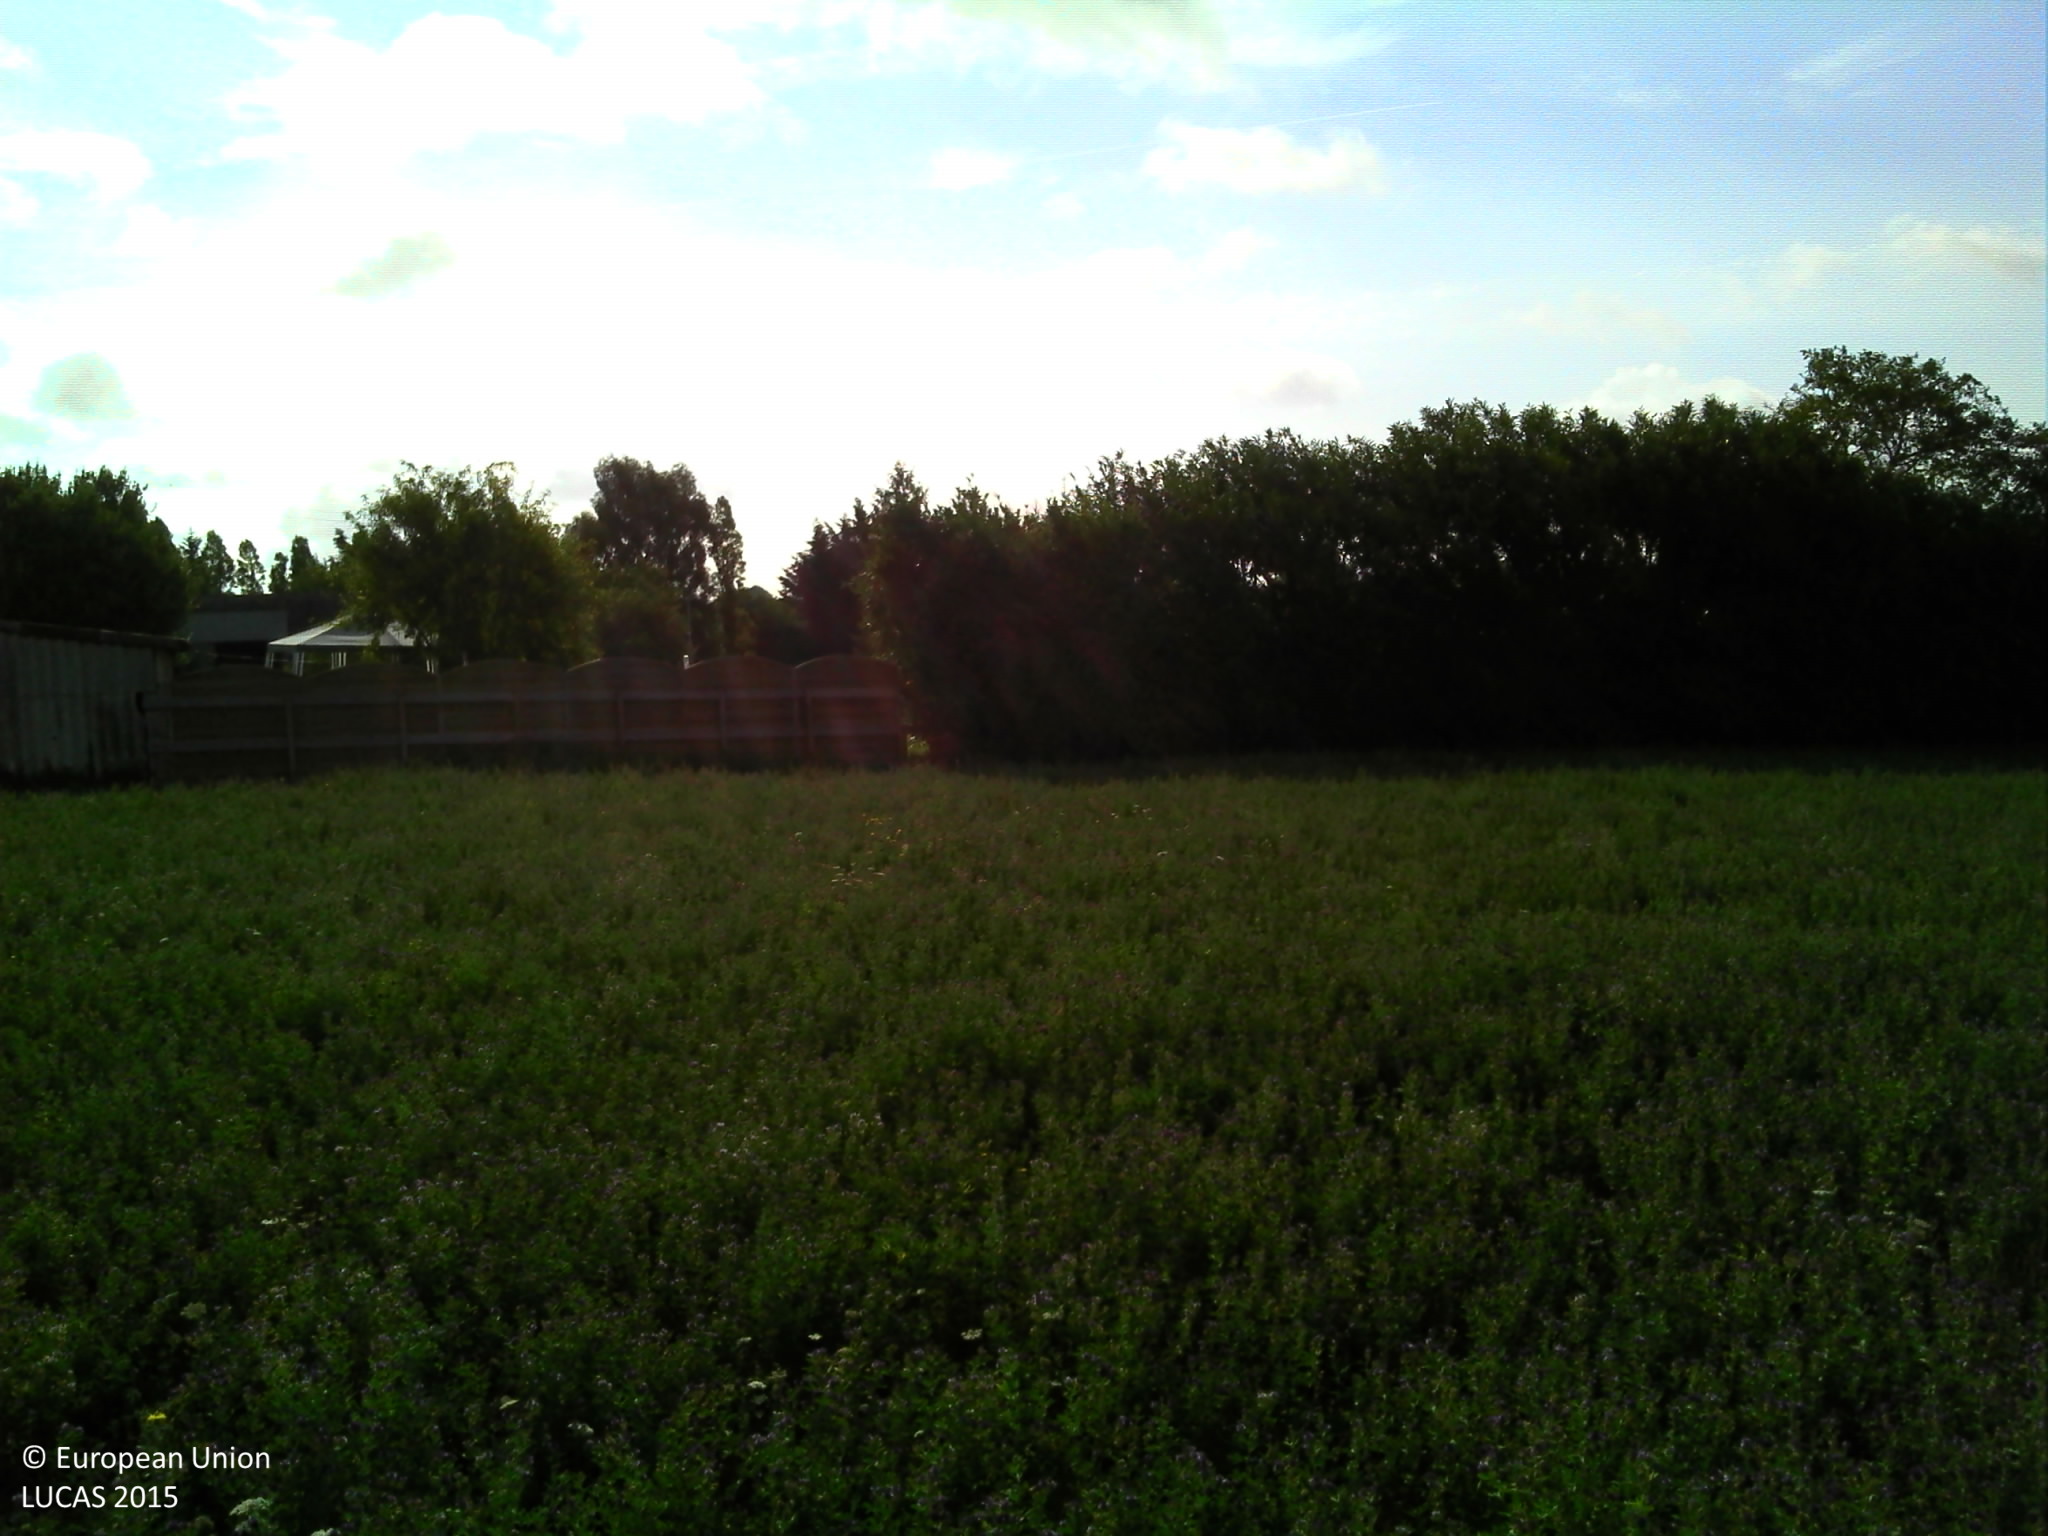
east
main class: Cropland
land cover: Lucerne
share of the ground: > 75 %
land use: Agriculture (excluding fallow land and kitchen gardens)
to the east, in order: Lucerne; Artificial constructions in urban areas; Apple fruit; Conifer hedges; Fences; Managed hedges; Grassland without tree/shrub cover
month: August
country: FR
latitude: 47.7755
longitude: -1.3994
